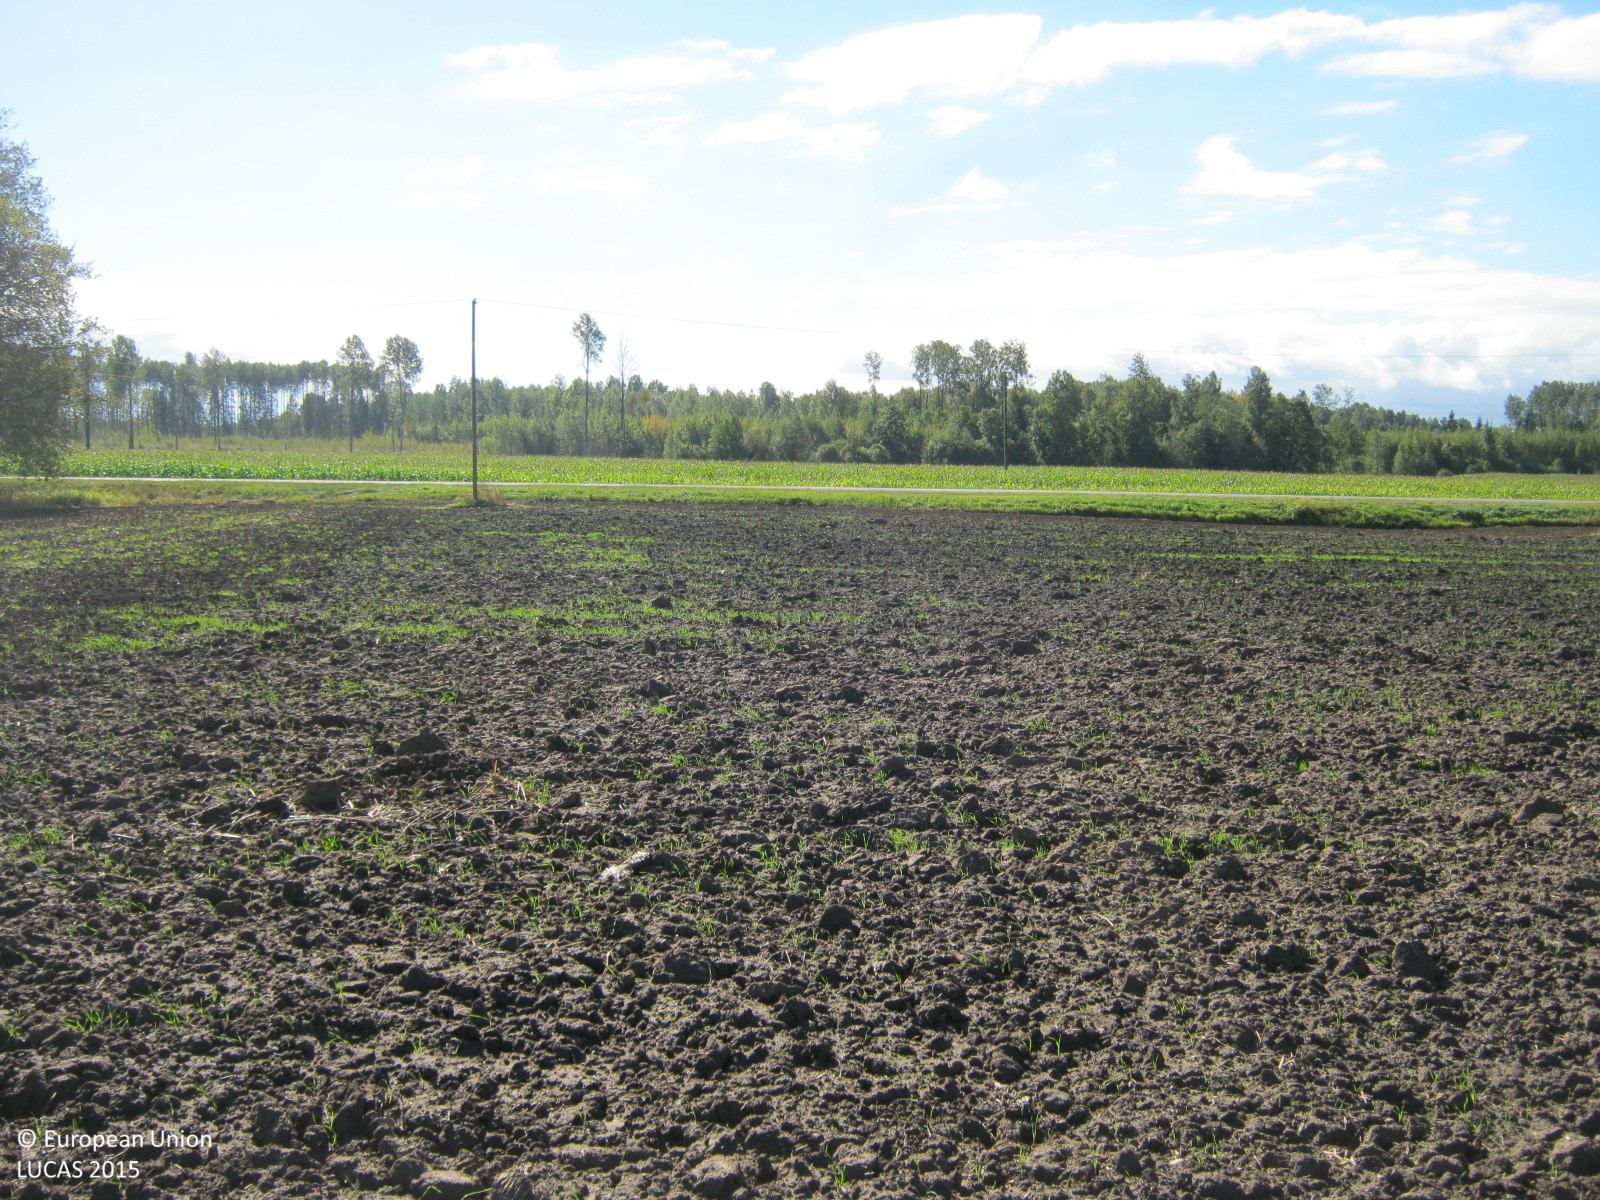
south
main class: Cropland
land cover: Common wheat
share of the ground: < 10 %
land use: Agriculture (excluding fallow land and kitchen gardens)
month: September
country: LV
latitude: 57.2761
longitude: 24.5393
